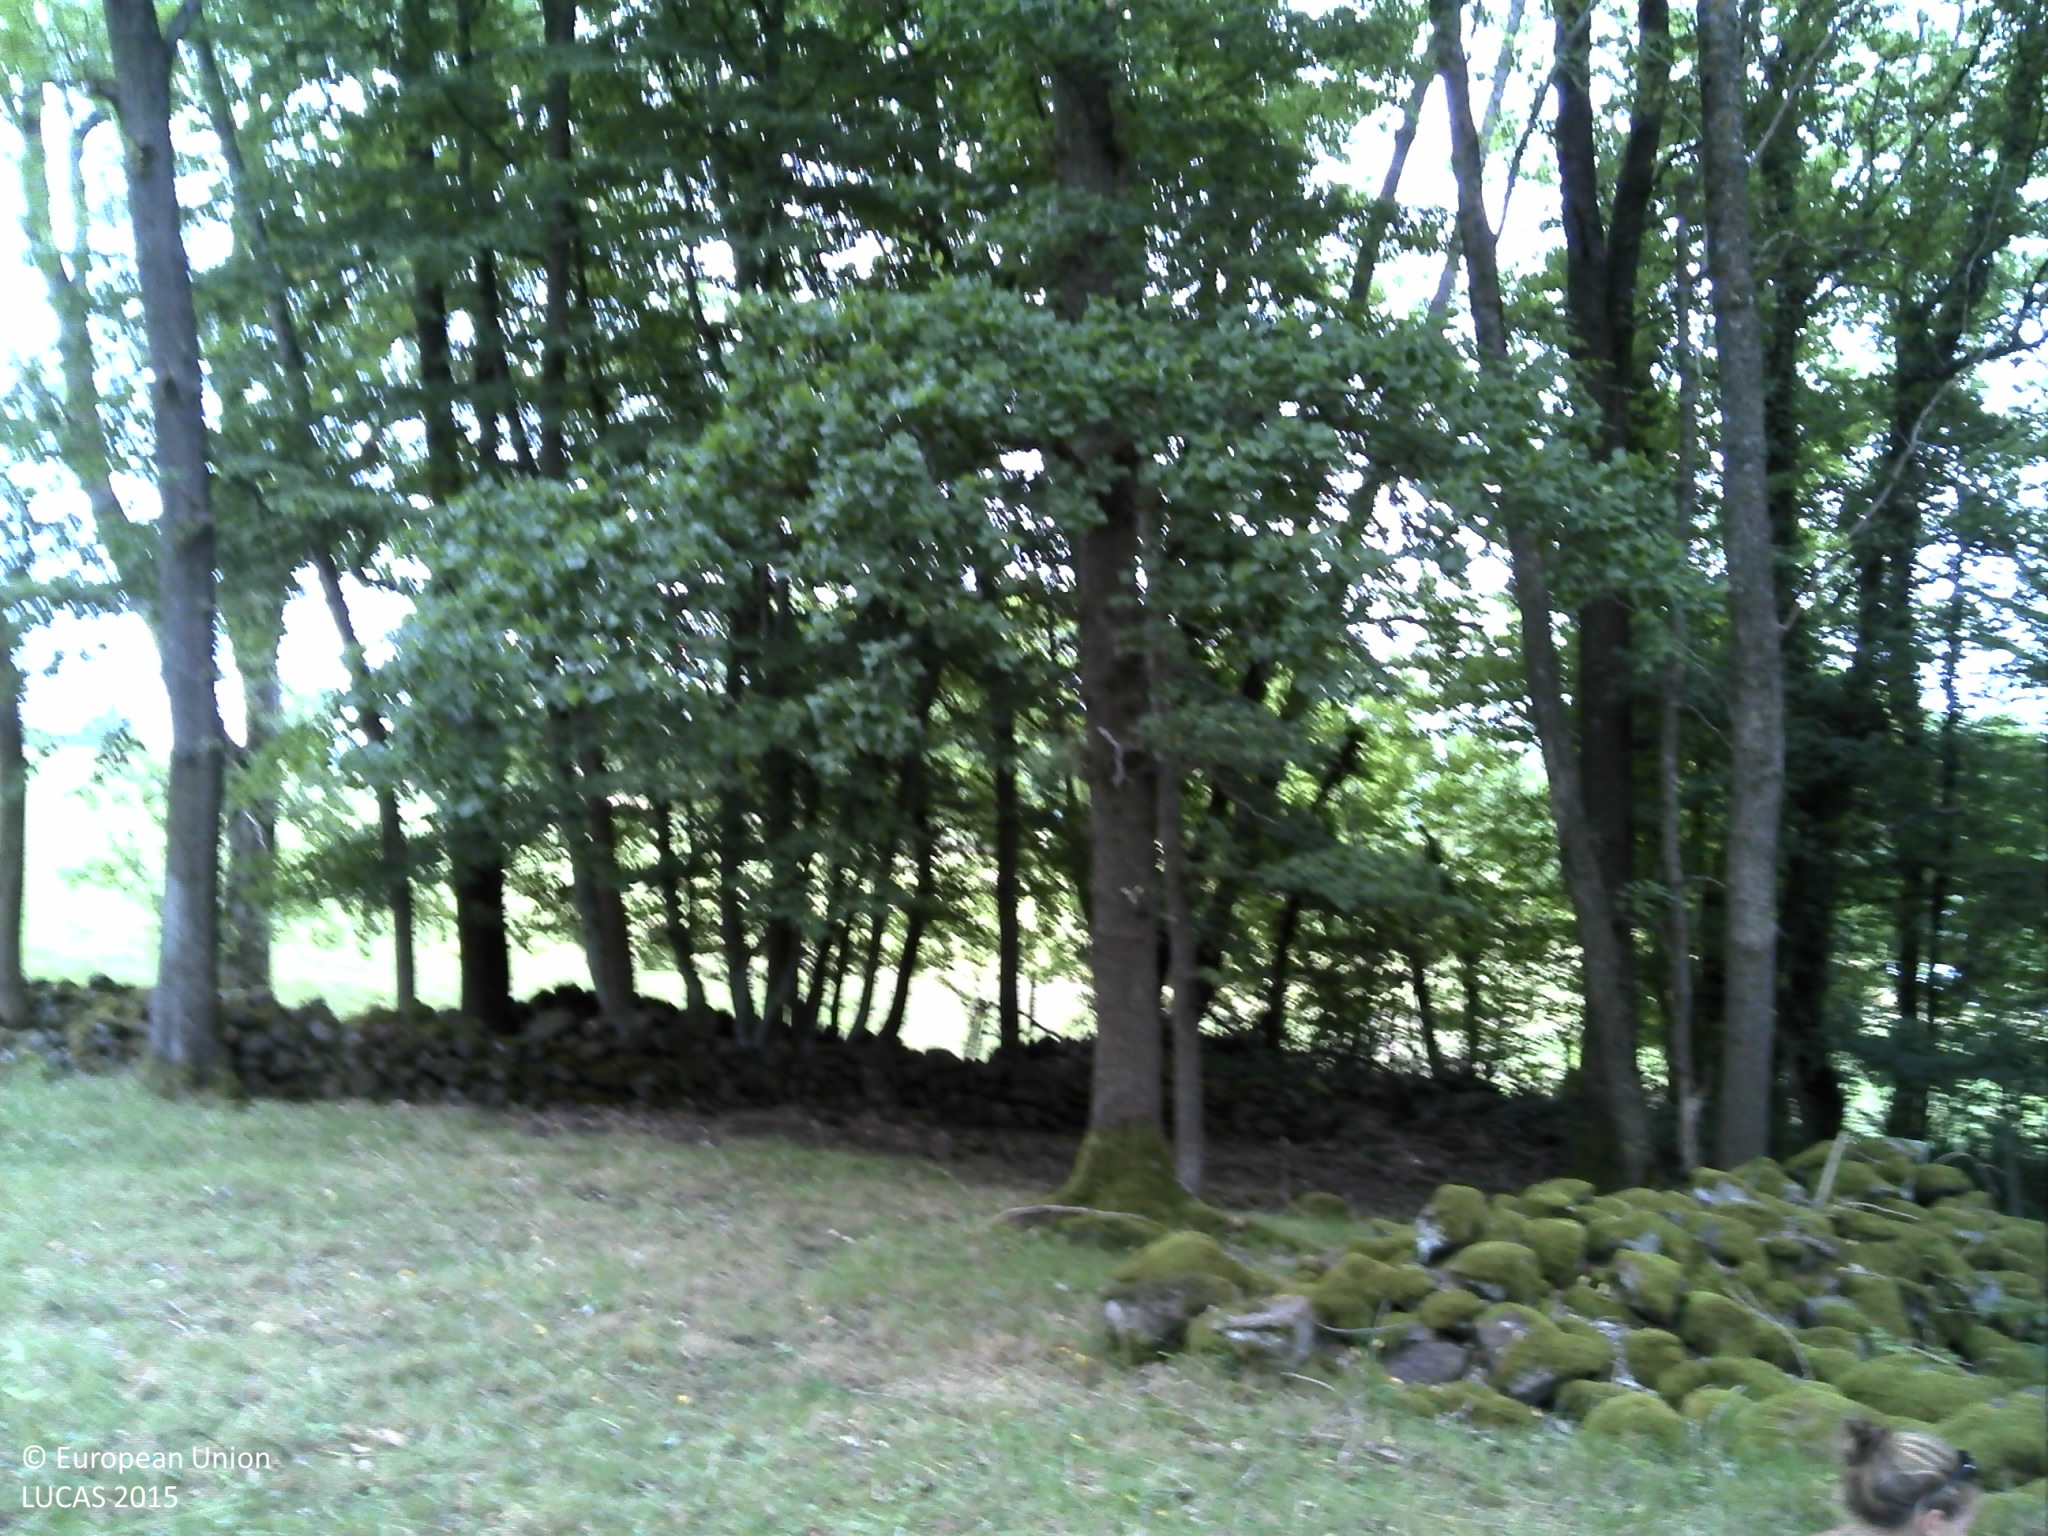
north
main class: Woodland
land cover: Broadleaved woodland
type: mesophytic deciduous forest
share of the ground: 25 - 50 %
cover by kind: herbaceous plants 50 %, broadleaved forest trees 40 %, shrubs 10 %
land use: Forestry
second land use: Agriculture (excluding fallow land and kitchen gardens)
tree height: > 5 m
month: July
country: FR
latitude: 45.6736
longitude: 3.3383
